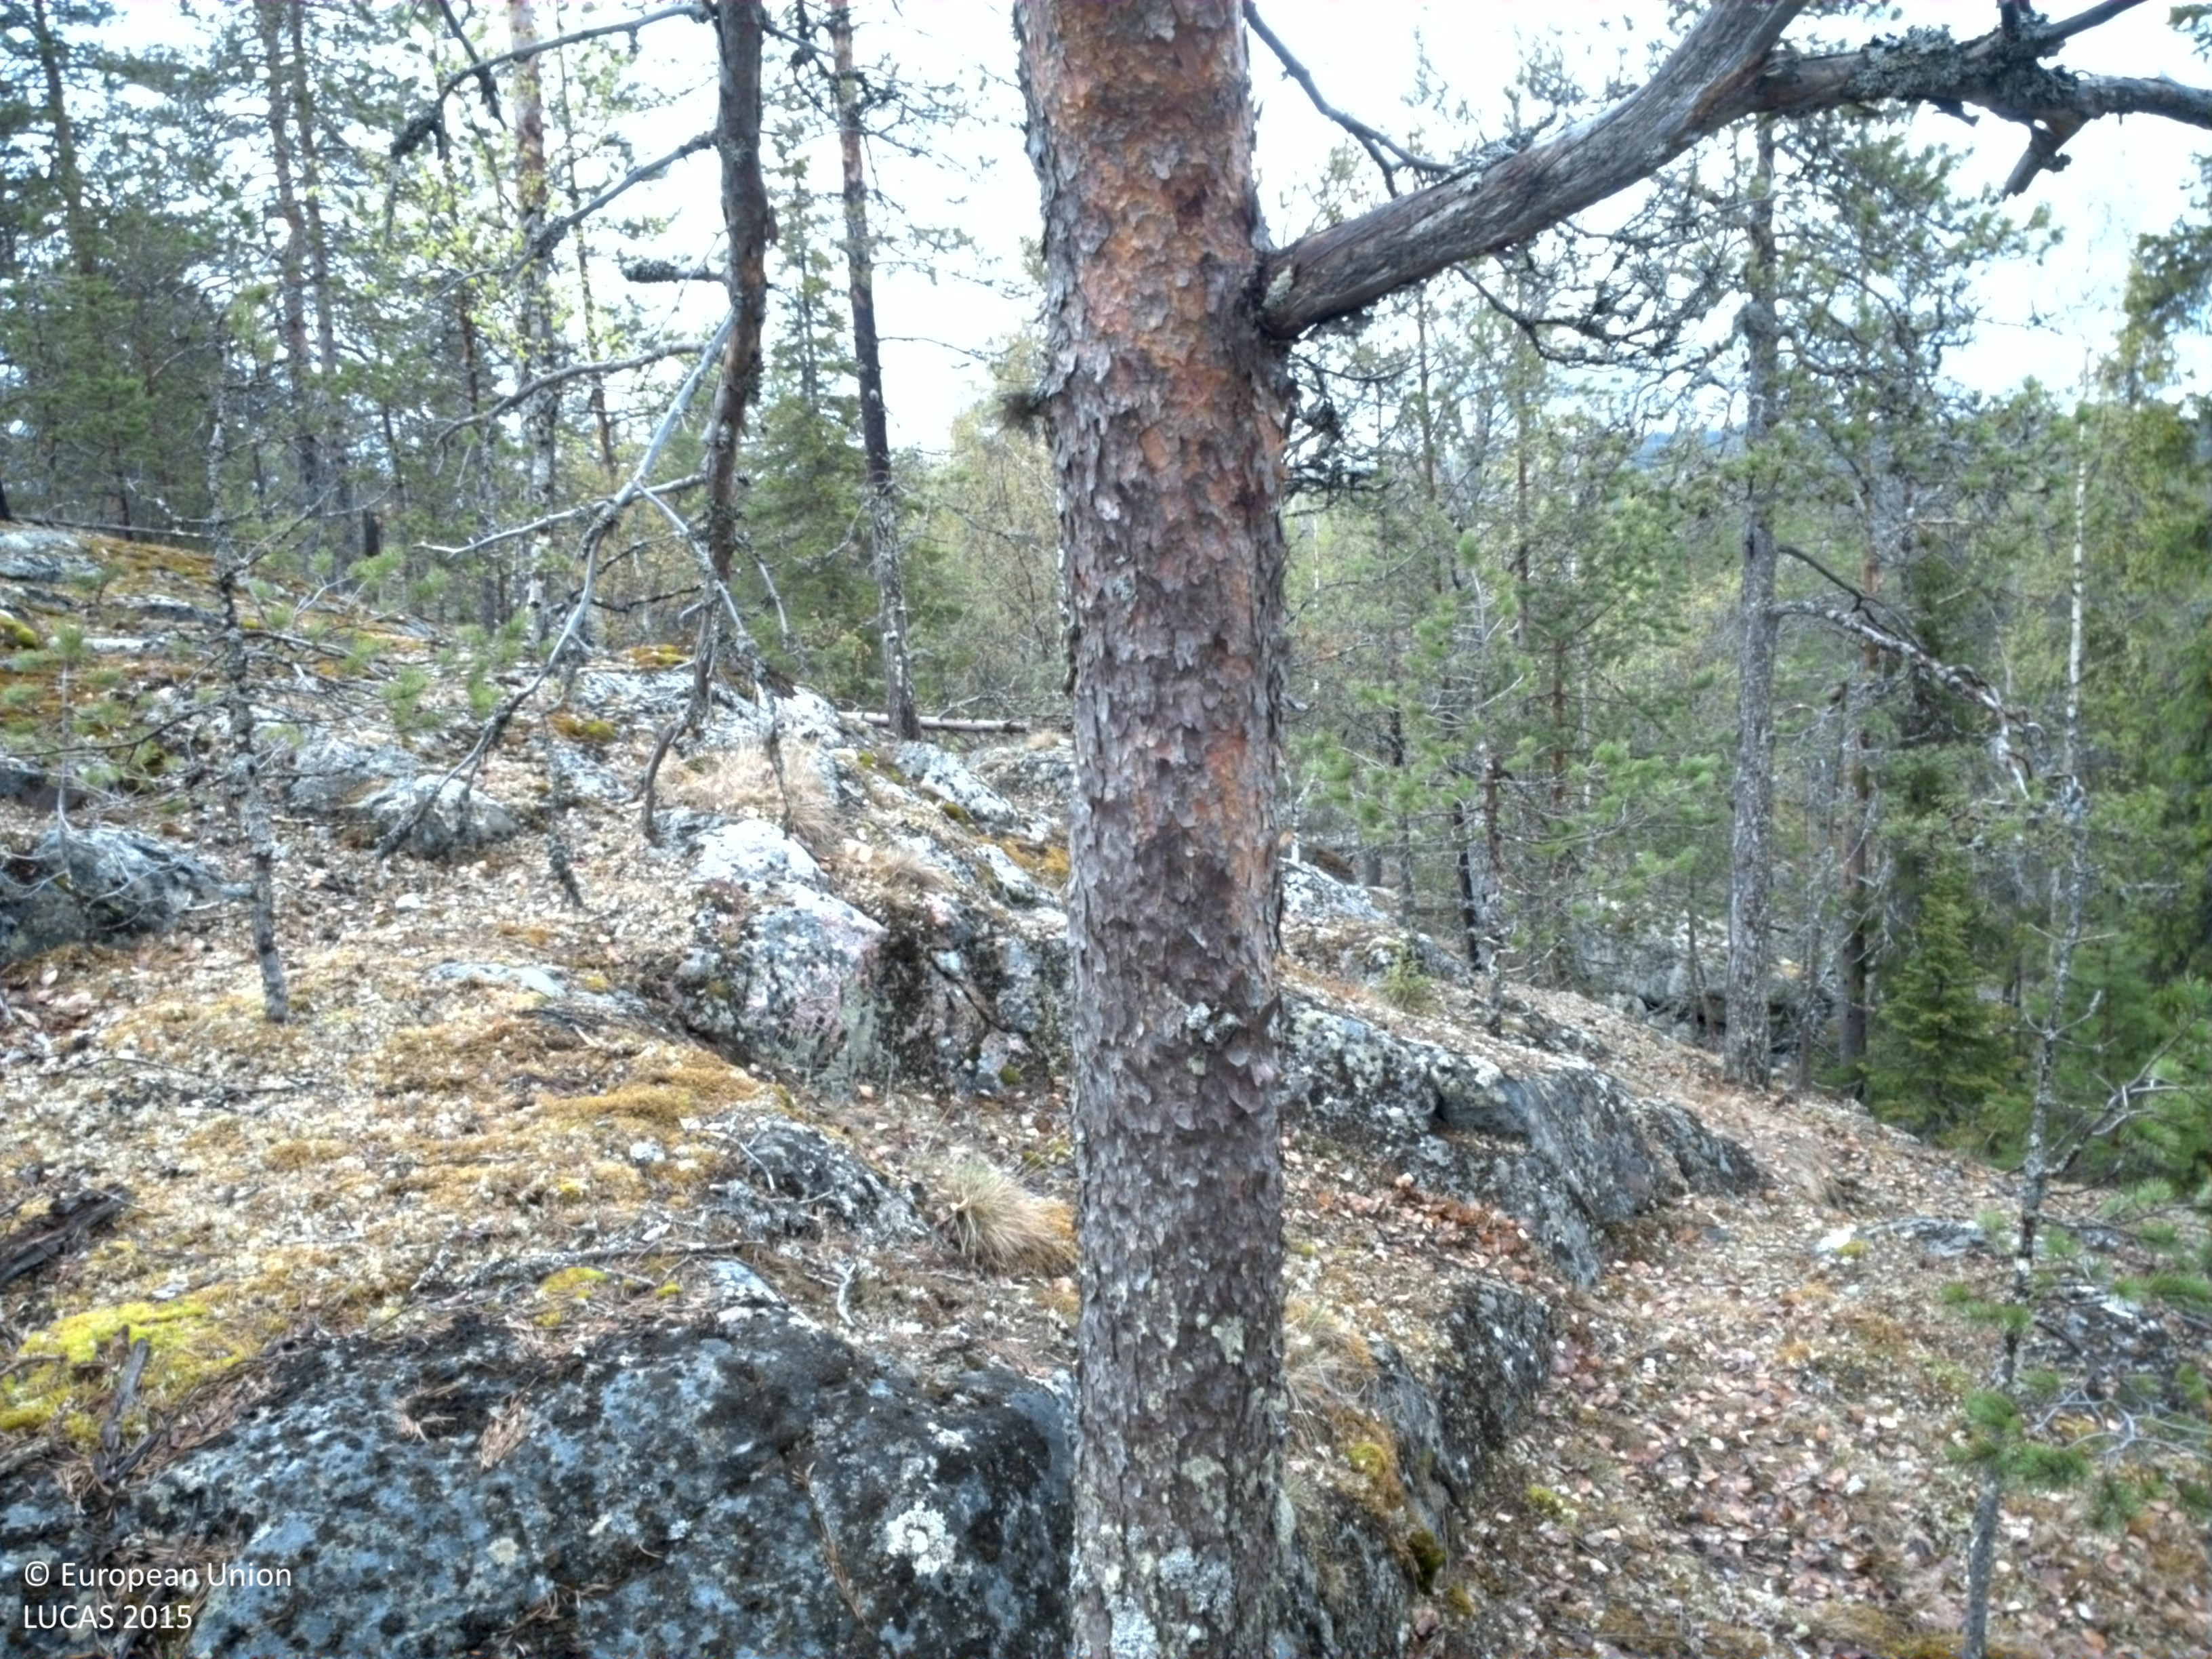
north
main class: Woodland
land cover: Pine dominated coniferous woodland
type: boreal forest
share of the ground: 25 - 50 %
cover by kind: coniferous forest trees 40 %, lichens and mosses 40 %, consolidated bare surface 10 %, broadleaved forest trees 5 %, shrubs 5 %
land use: Semi-natural and natural areas not in use
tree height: > 5 m
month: May
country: SE
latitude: 66.0593
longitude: 23.0806
